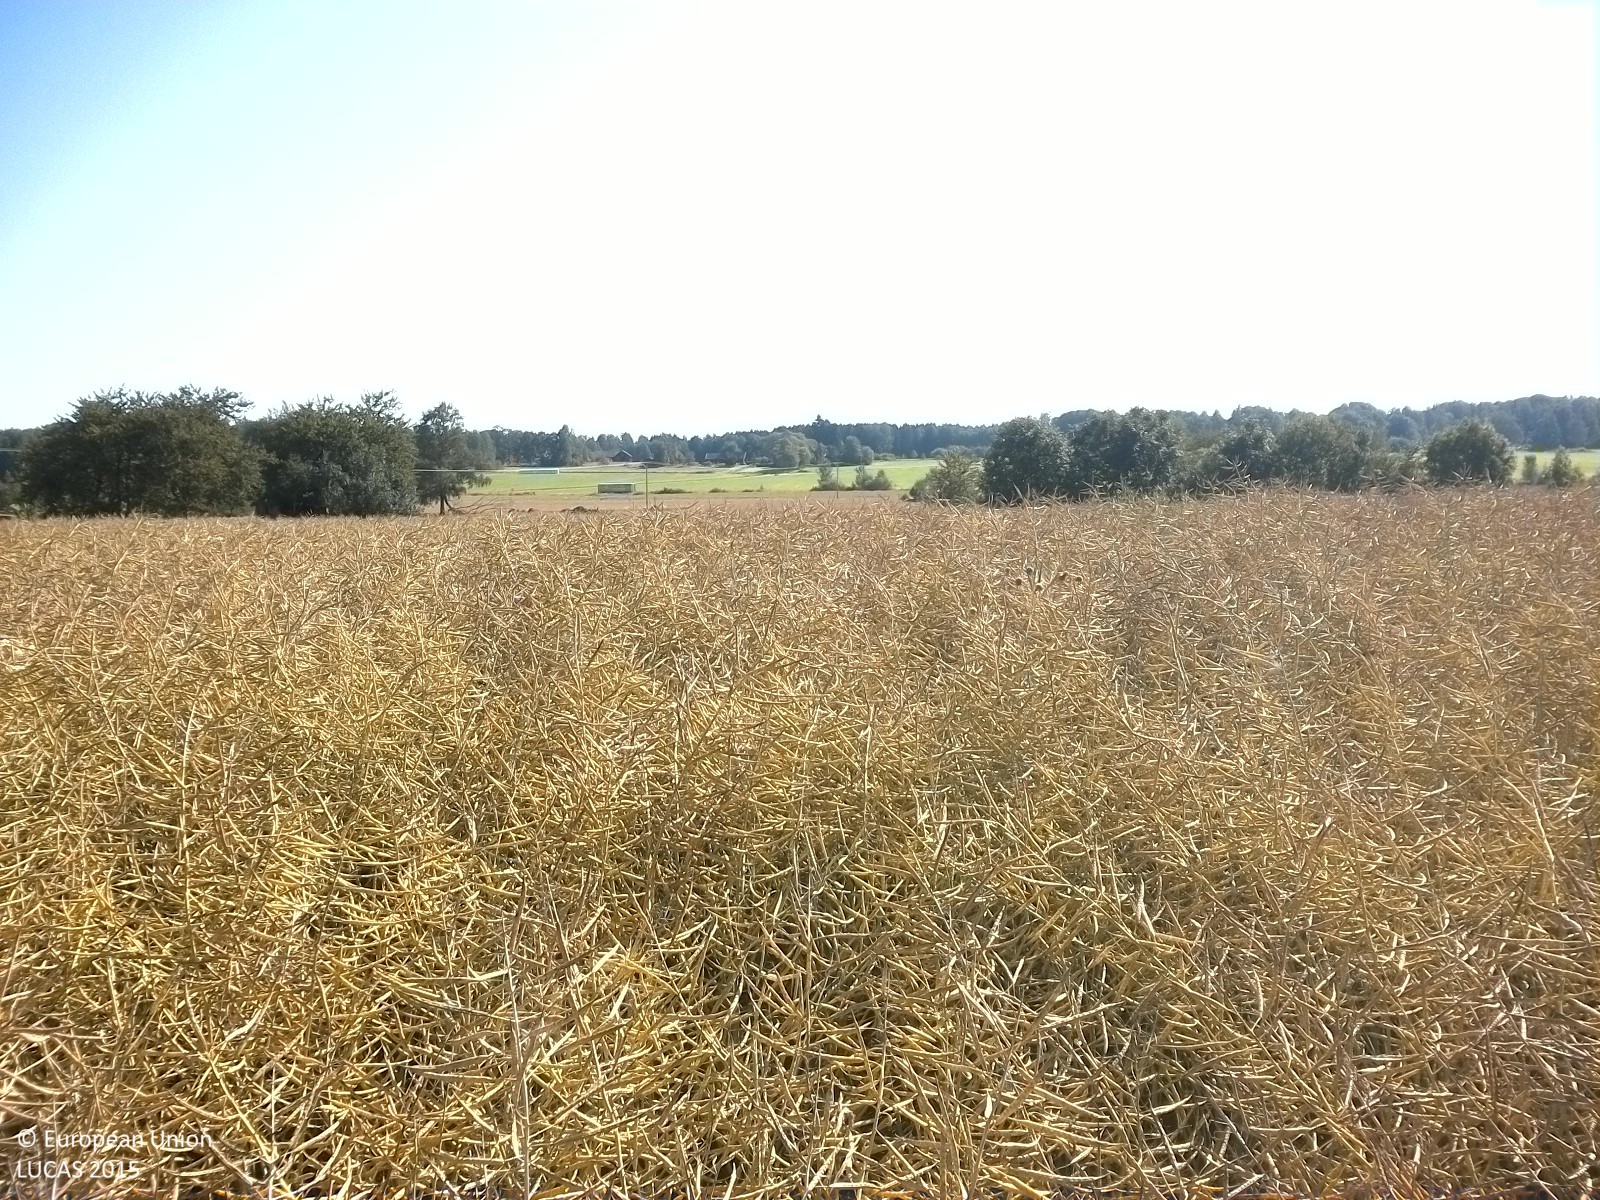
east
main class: Cropland
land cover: Rape and turnip rape
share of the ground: > 75 %
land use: Agriculture (excluding fallow land and kitchen gardens)
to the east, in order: Rape and turnip rape; Fences; Grassland without tree/shrub cover; Fences; Grass margins; Rape and turnip rape
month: August
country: SE
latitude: 59.0497
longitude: 15.3791
